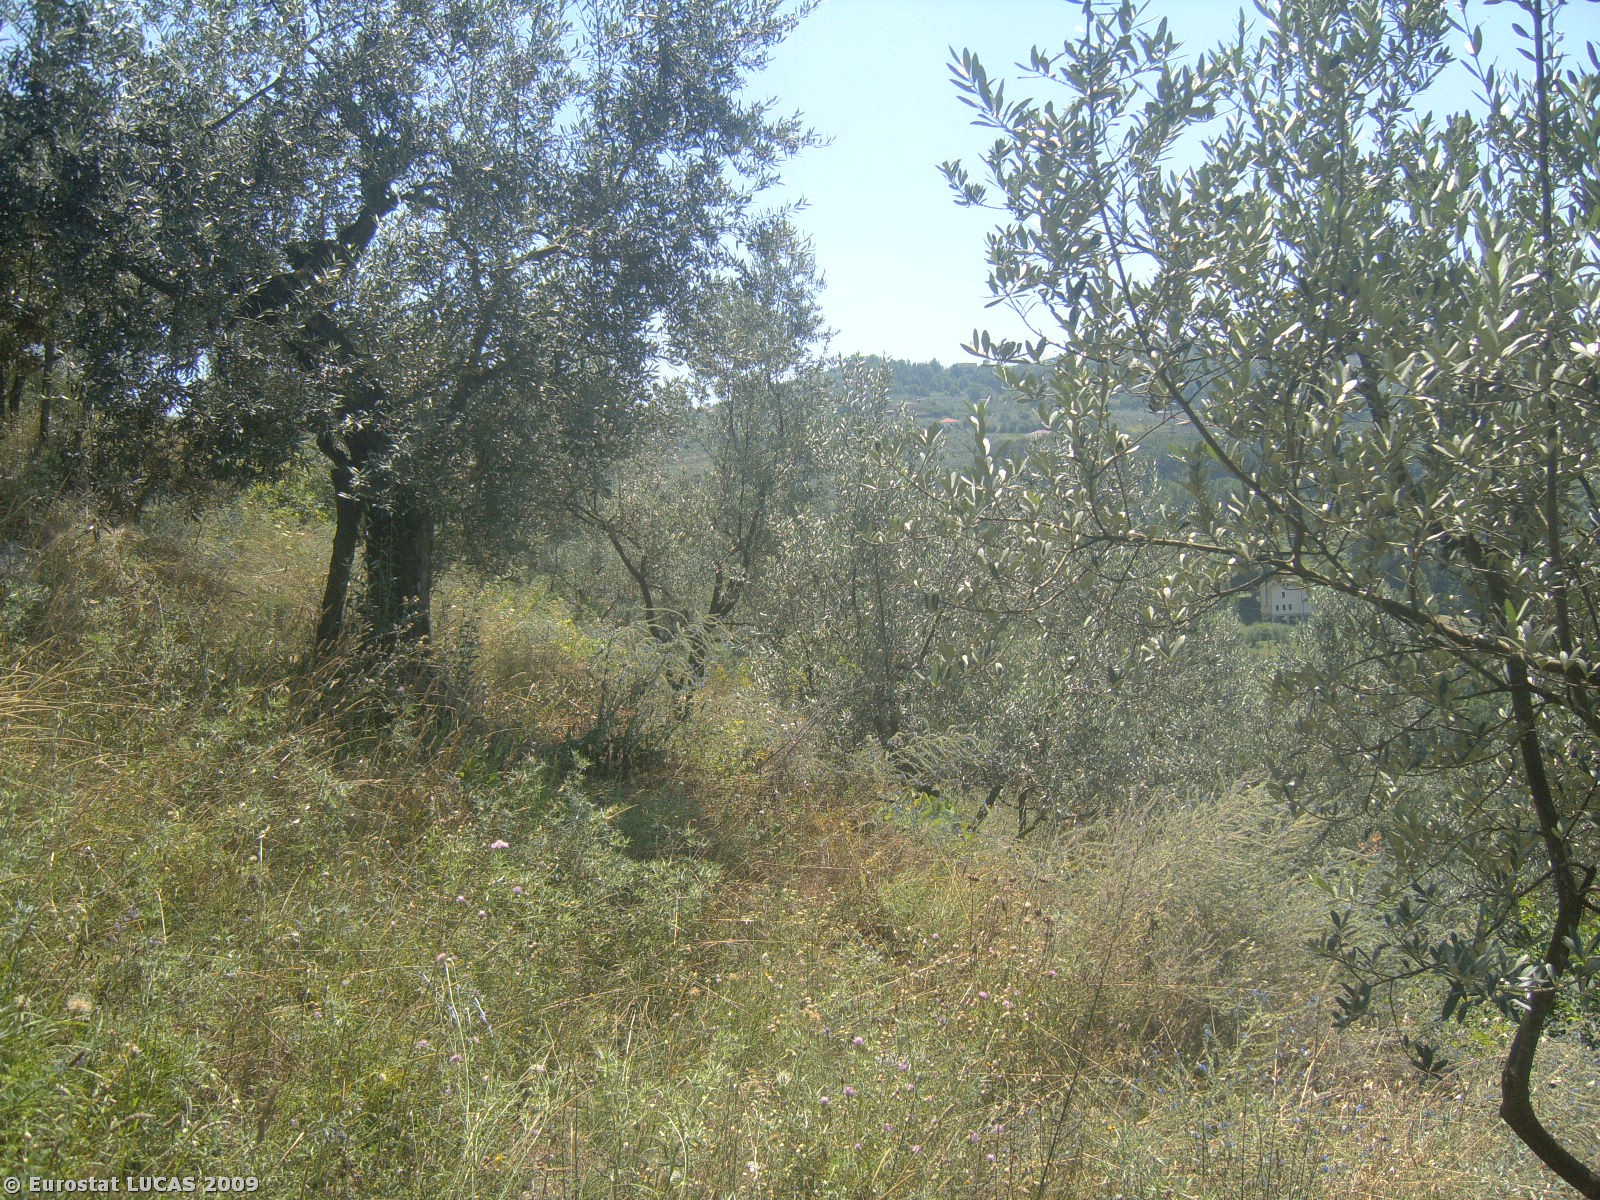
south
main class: Cropland
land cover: Olive groves
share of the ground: > 75 %
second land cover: Grassland with sparse tree/shrub cover
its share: 25 - 50 %
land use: Agriculture (excluding fallow land and kitchen gardens)
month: July
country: IT
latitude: 41.6496
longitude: 13.6008
